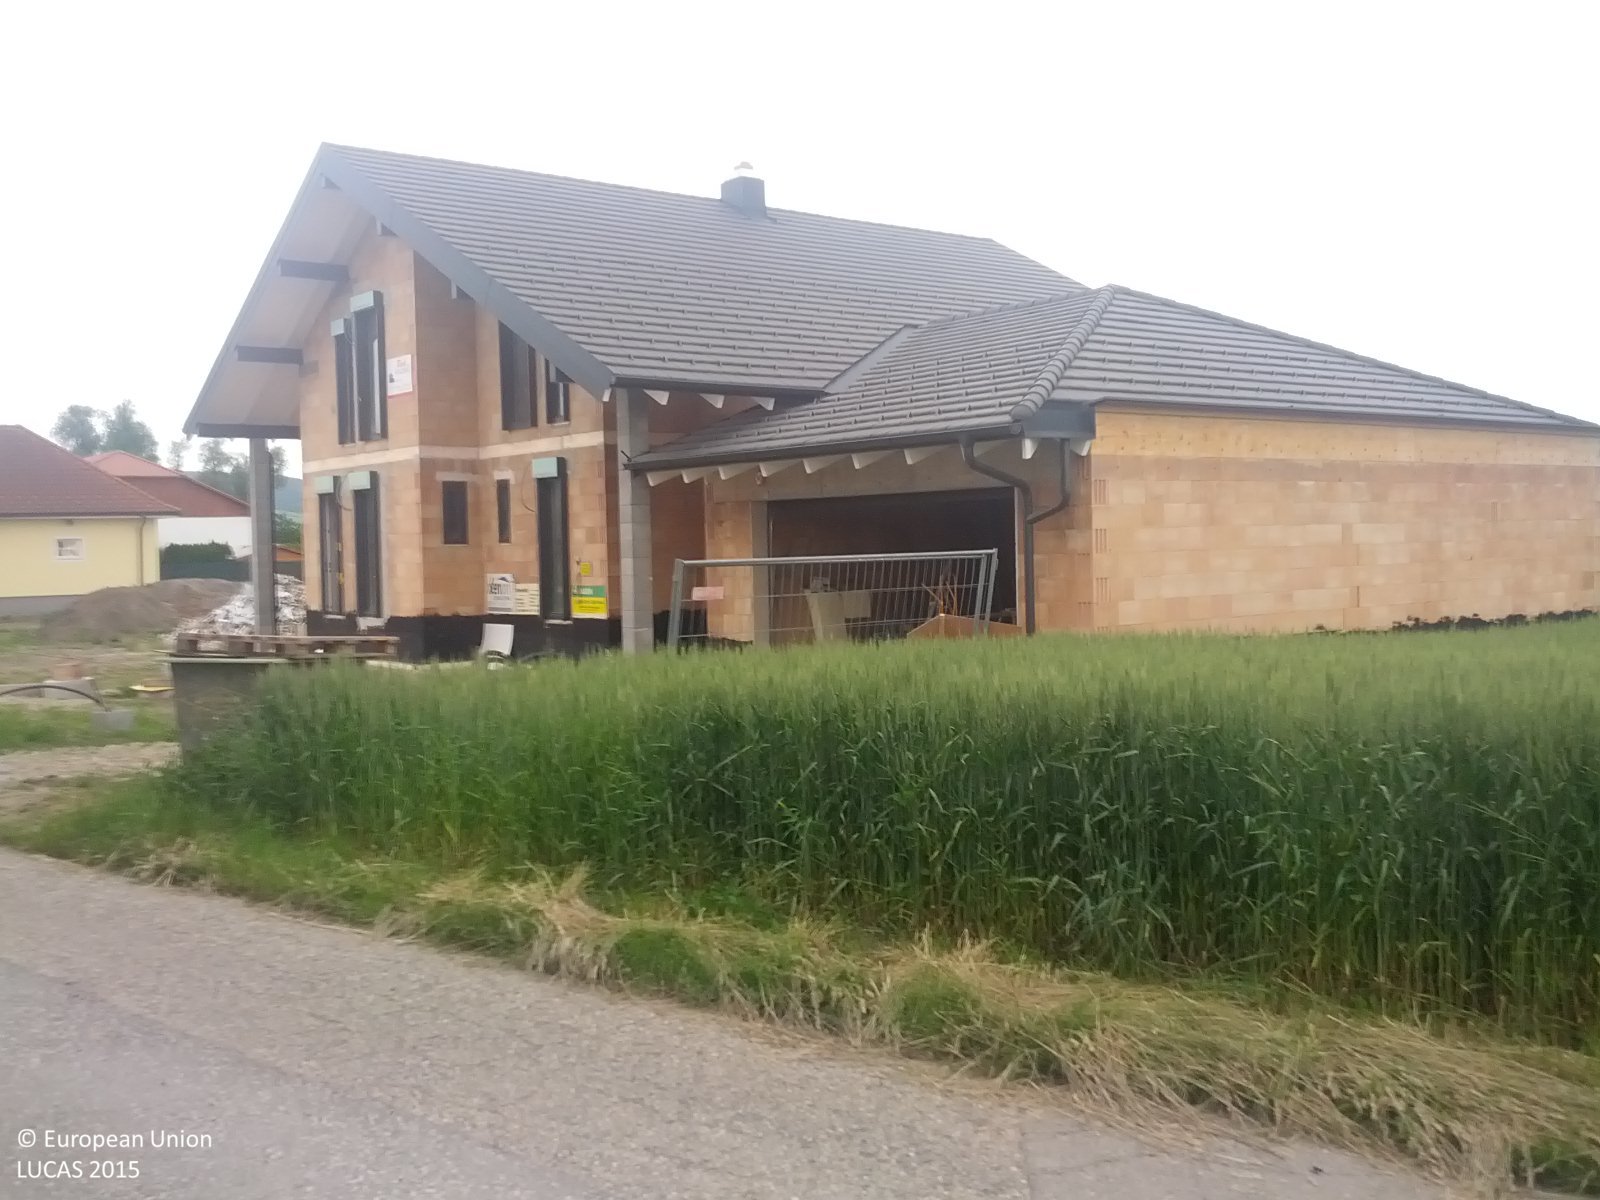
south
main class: Grassland
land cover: Grassland with sparse tree/shrub cover
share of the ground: > 75 %
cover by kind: herbaceous plants 90 %, coniferous forest trees 5 %, shrubs 5 %
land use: Residential
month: May
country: AT
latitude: 48.3230
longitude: 16.1409
